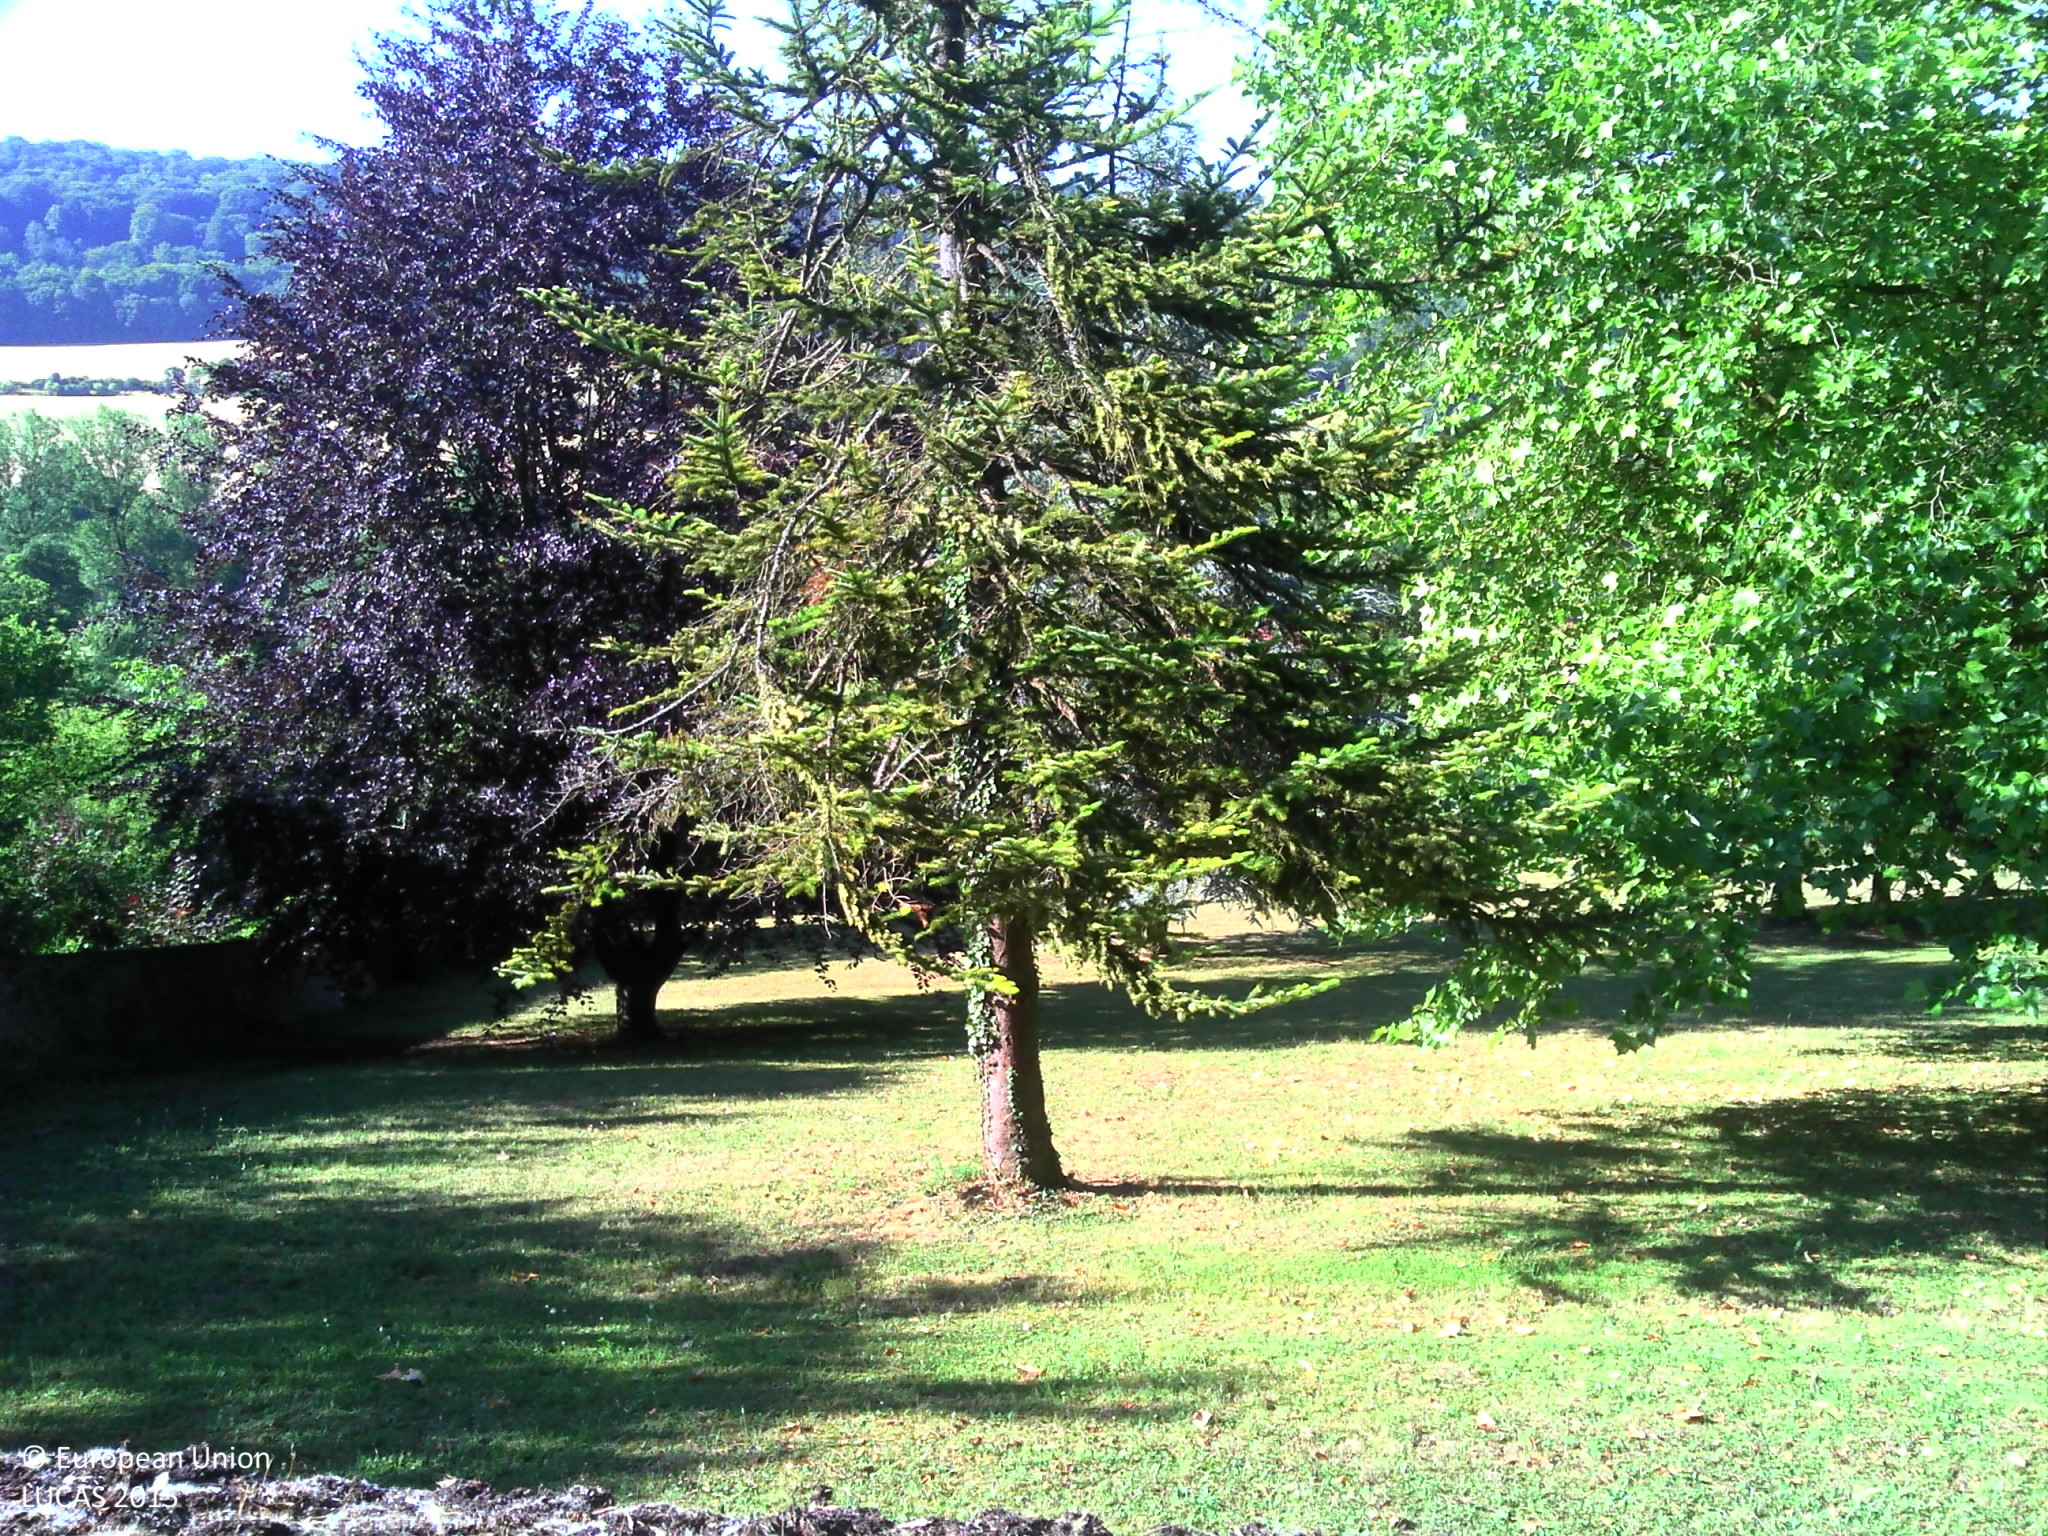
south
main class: Grassland
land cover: Grassland with sparse tree/shrub cover
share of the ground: > 75 %
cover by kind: herbaceous plants 95 %, broadleaved forest trees 5 %
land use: Residential
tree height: > 5 m
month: June
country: FR
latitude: 49.0154
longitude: 5.9933
